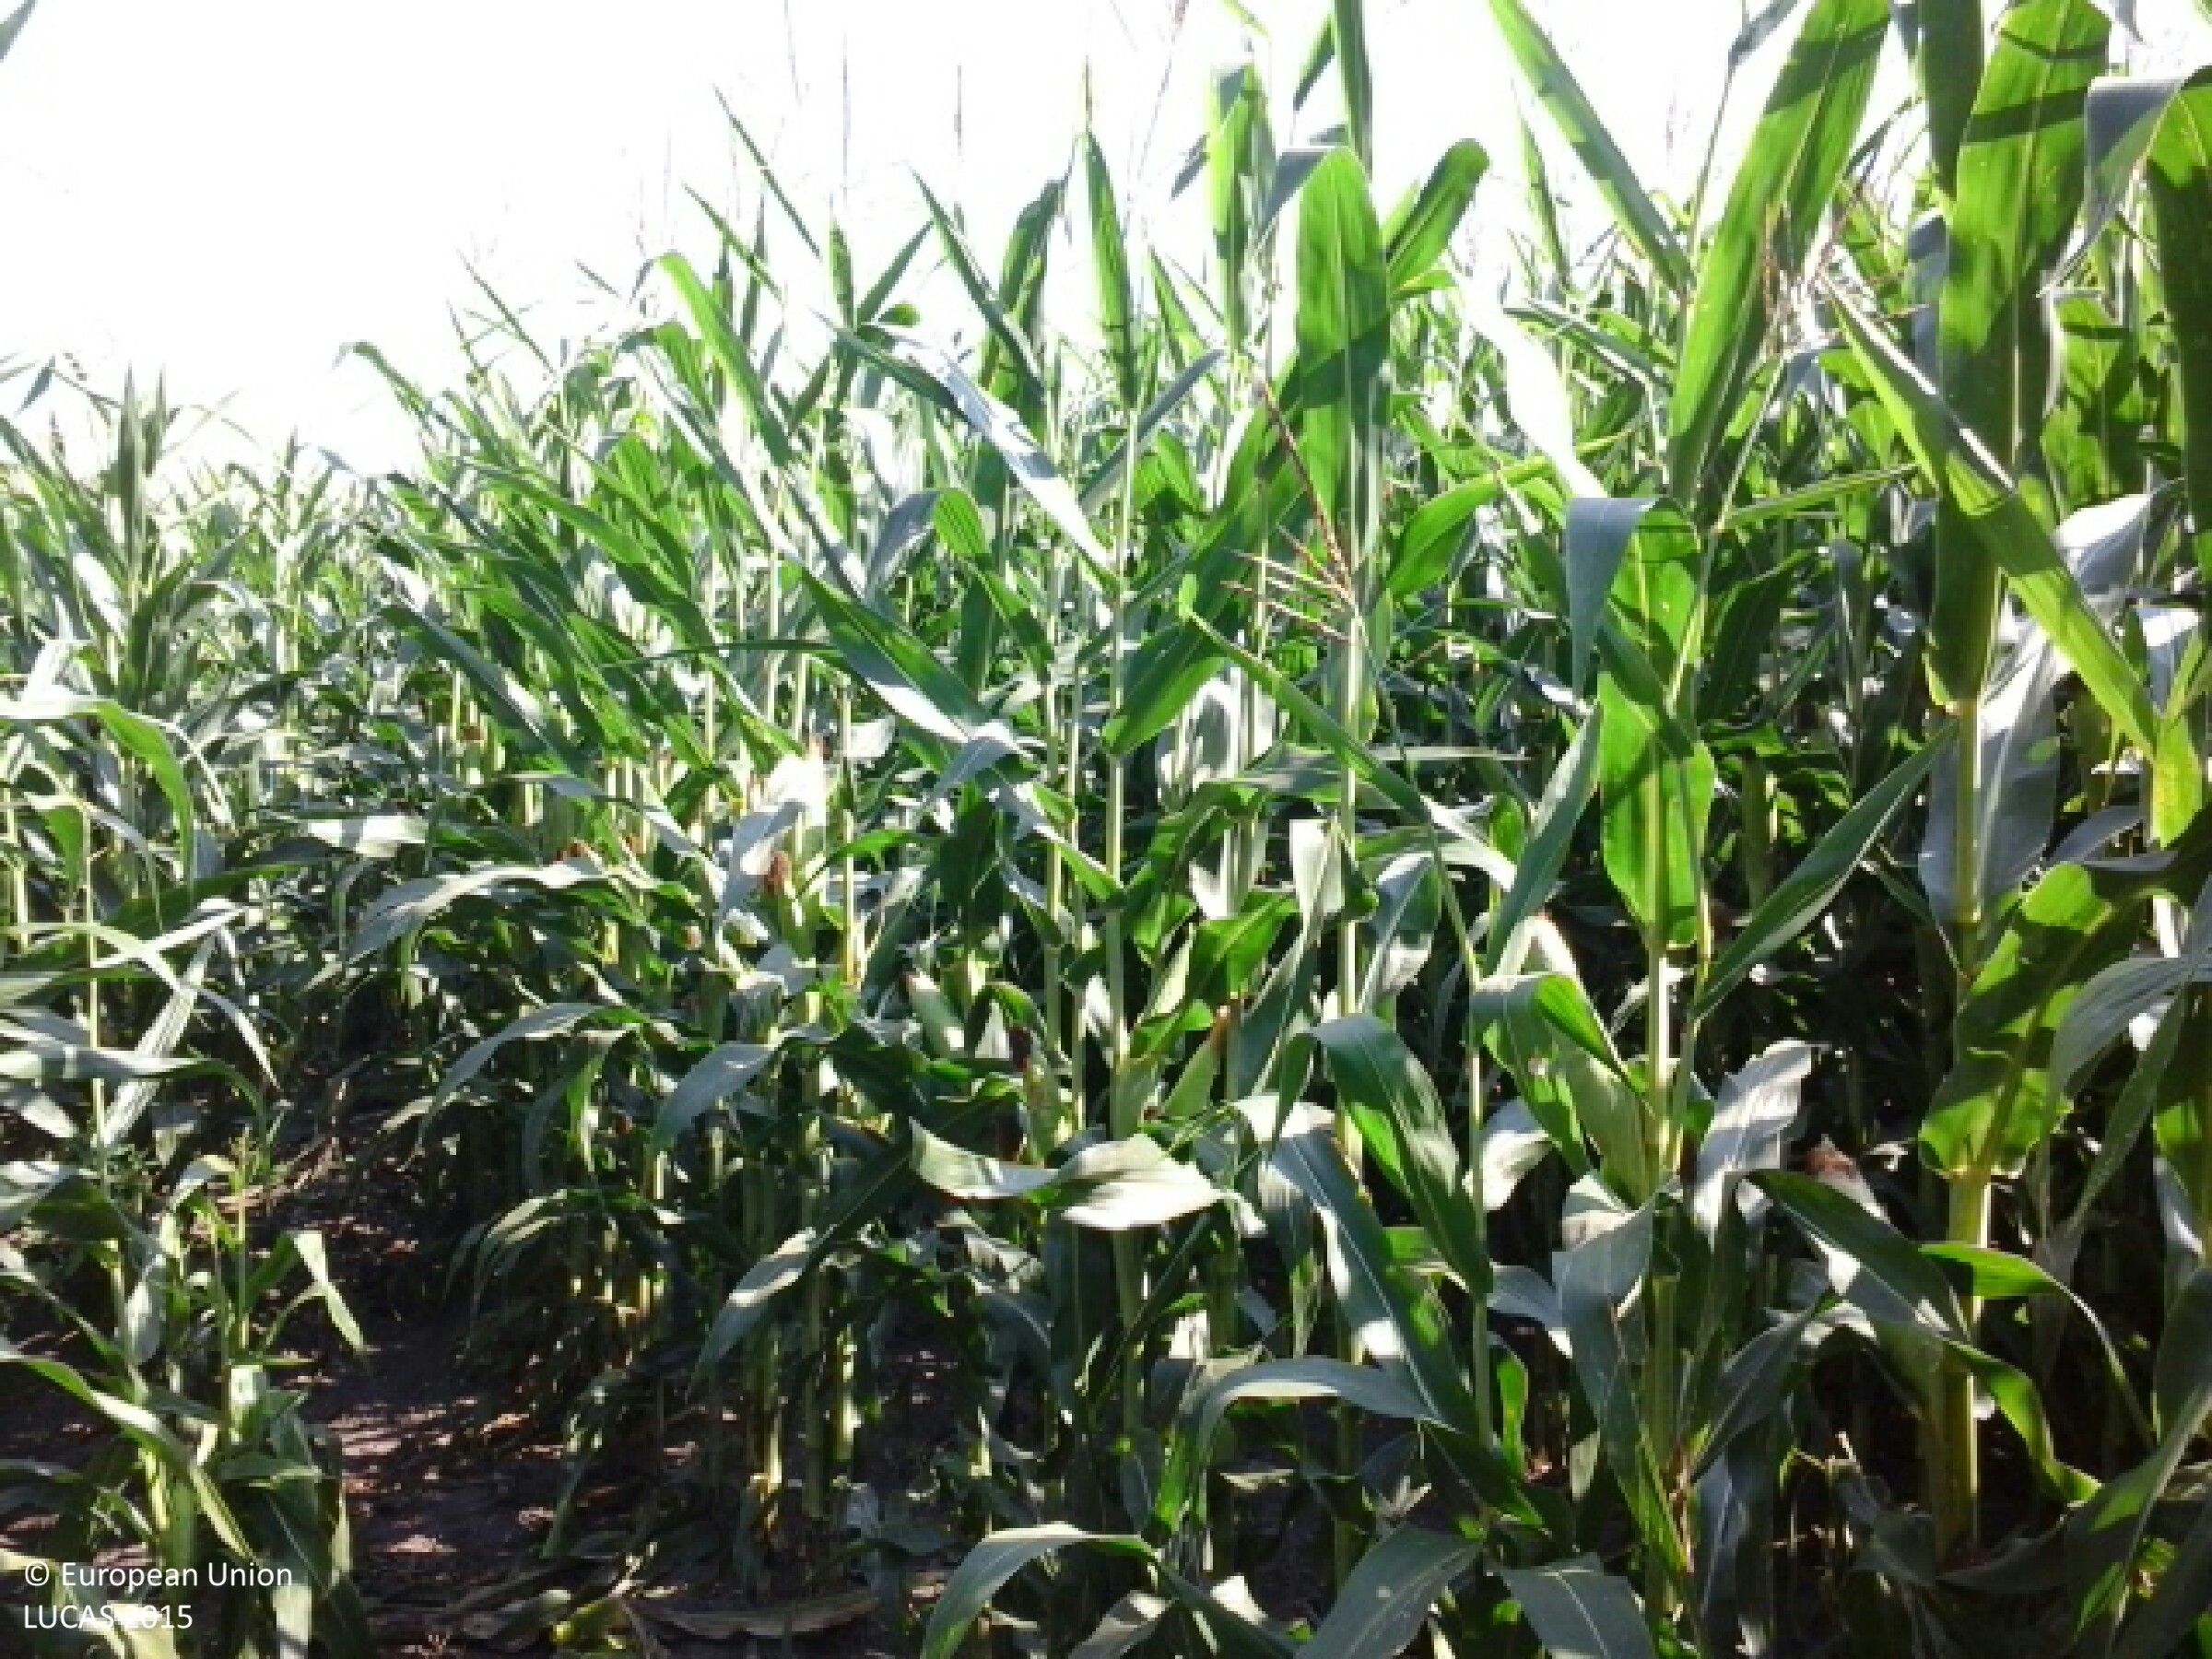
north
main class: Cropland
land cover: Maize
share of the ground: > 75 %
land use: Agriculture (excluding fallow land and kitchen gardens)
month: August
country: HU
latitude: 47.5549
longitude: 17.9709
